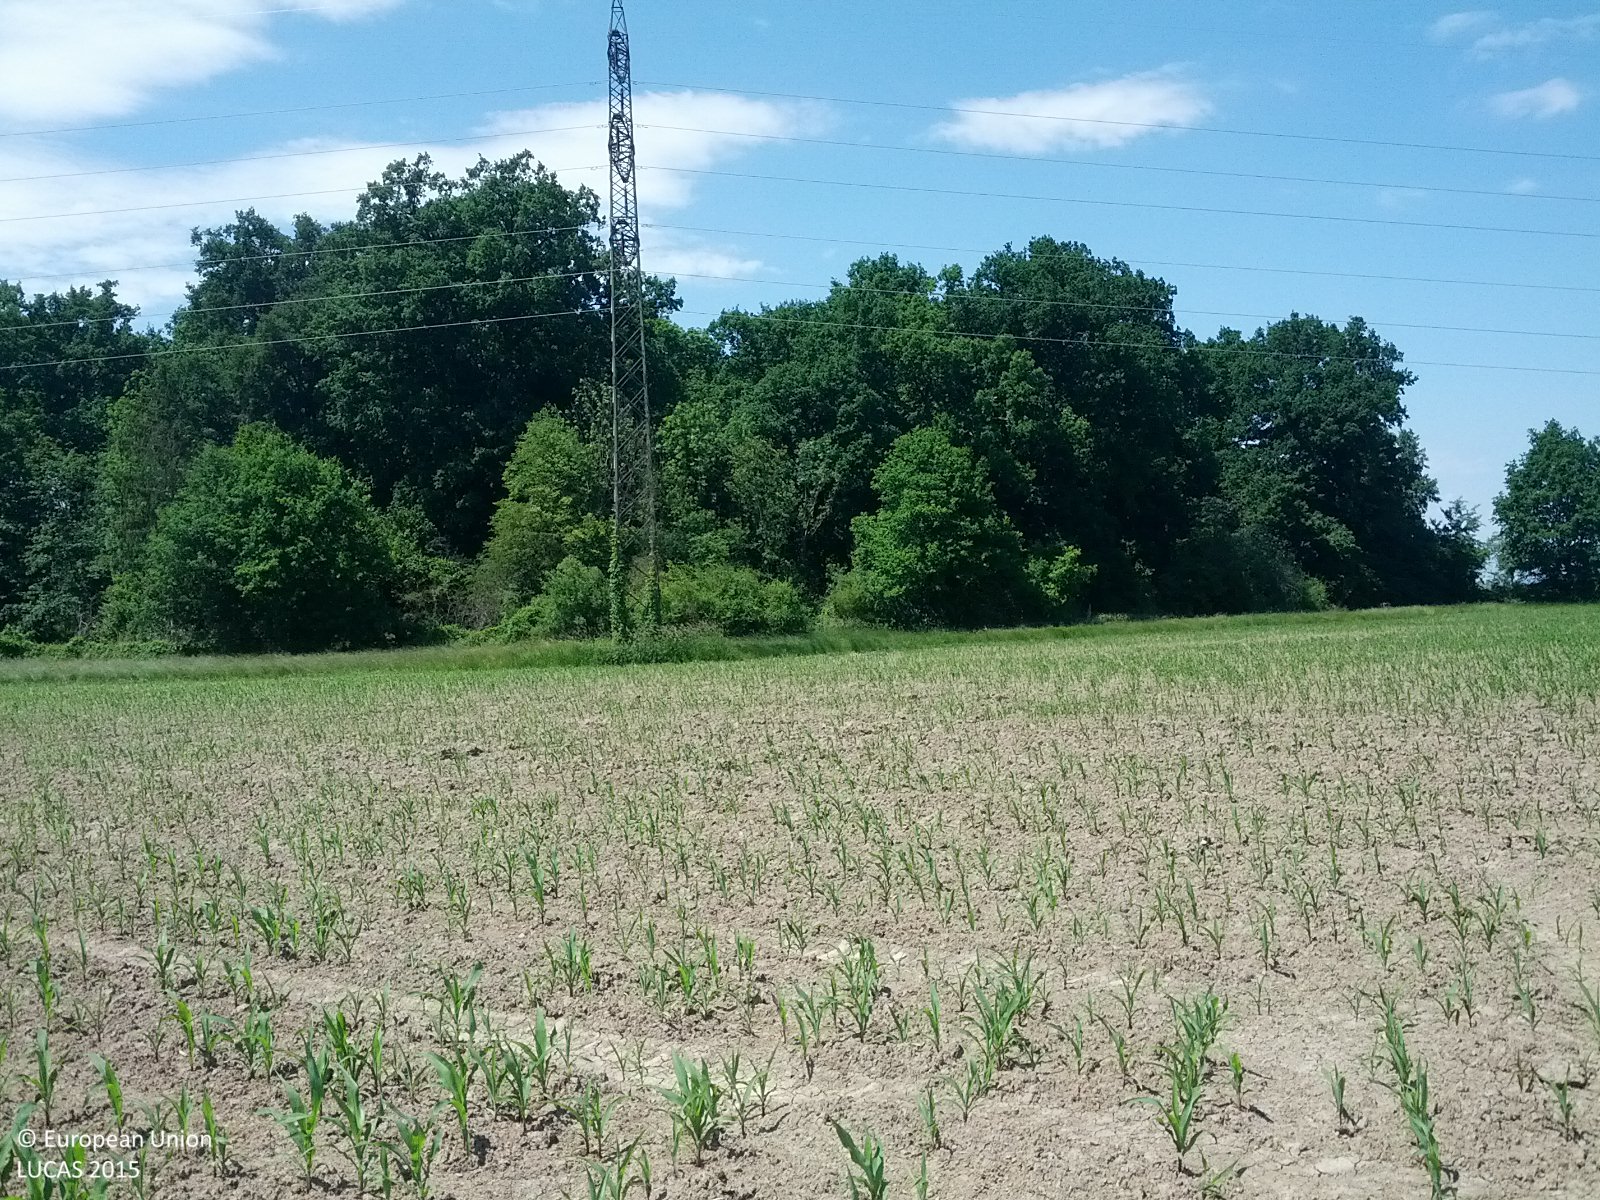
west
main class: Cropland
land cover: Maize
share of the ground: 10 - 25 %
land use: Agriculture (excluding fallow land and kitchen gardens)
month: June
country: AT
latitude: 47.0679
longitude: 16.3094
